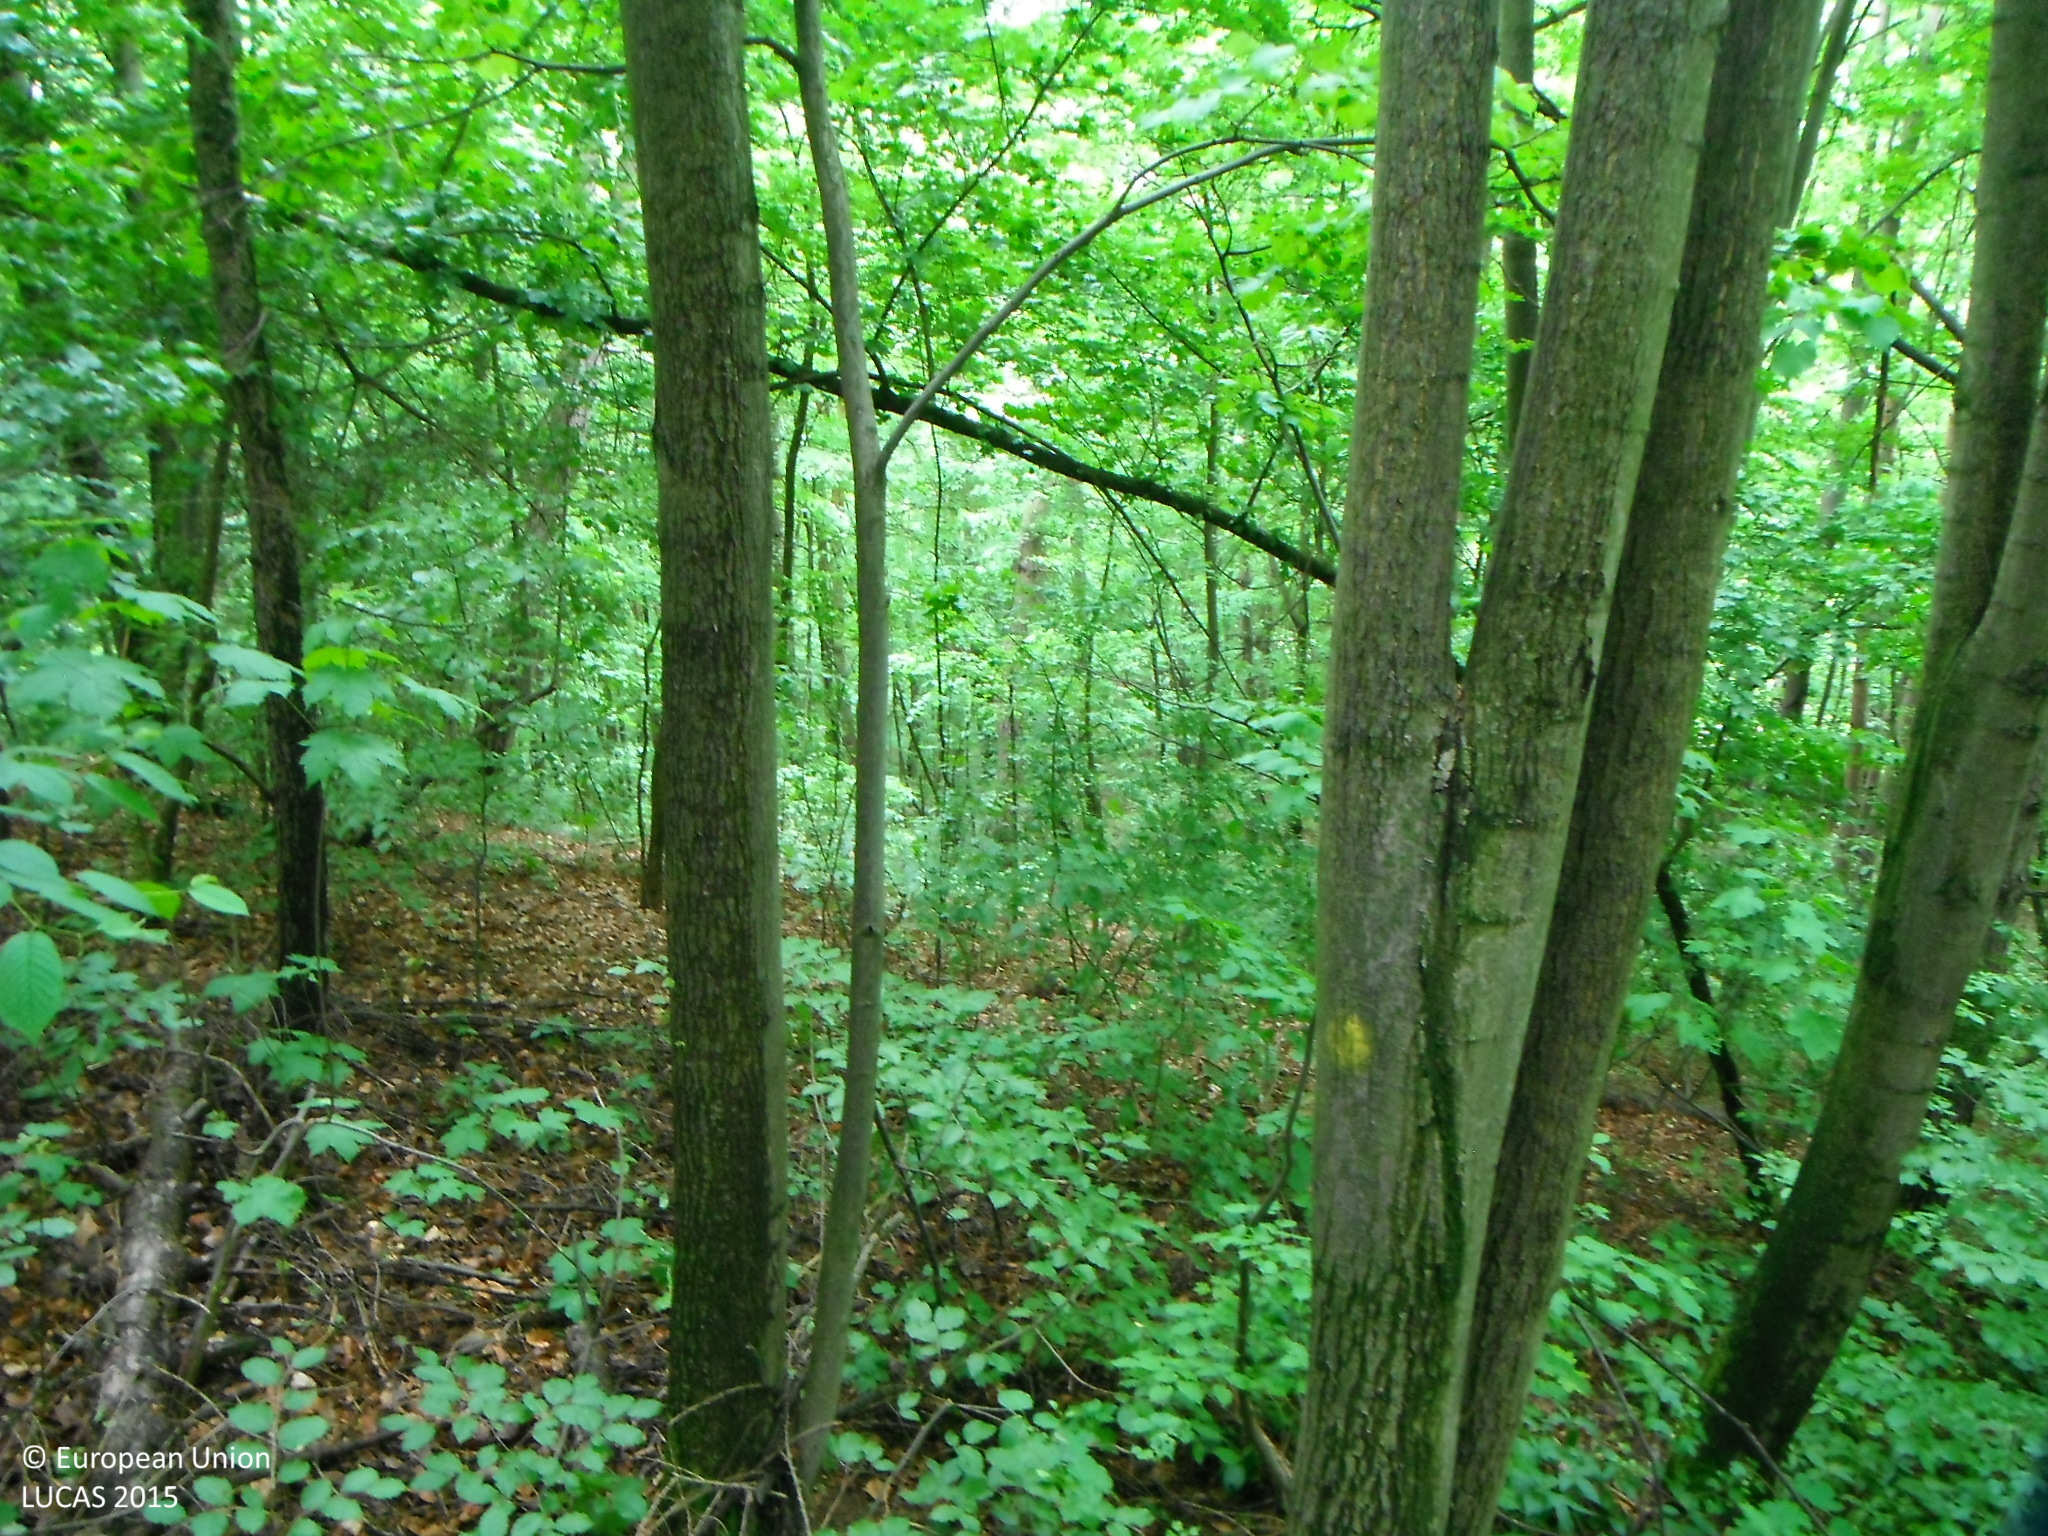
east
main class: Woodland
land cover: Other mixed woodland
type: hemiboreal forest and nemoral coniferous forest and mixed broadleaved-coniferous forest
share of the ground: > 75 %
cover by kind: broadleaved forest trees 60 %, coniferous forest trees 40 %
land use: Forestry
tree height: > 5 m
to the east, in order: Other mixed woodland; Tracks; Pine dominated mixed woodland; Broadleaved woodland; Grassland without tree/shrub cover; Tracks; Grassland without tree/shrub cover; Single bushes/trees; Artificial constructions in urban areas; Single bushes/trees; Grassland without tree/shrub cover
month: May
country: SK
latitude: 48.7300
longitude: 19.1448
